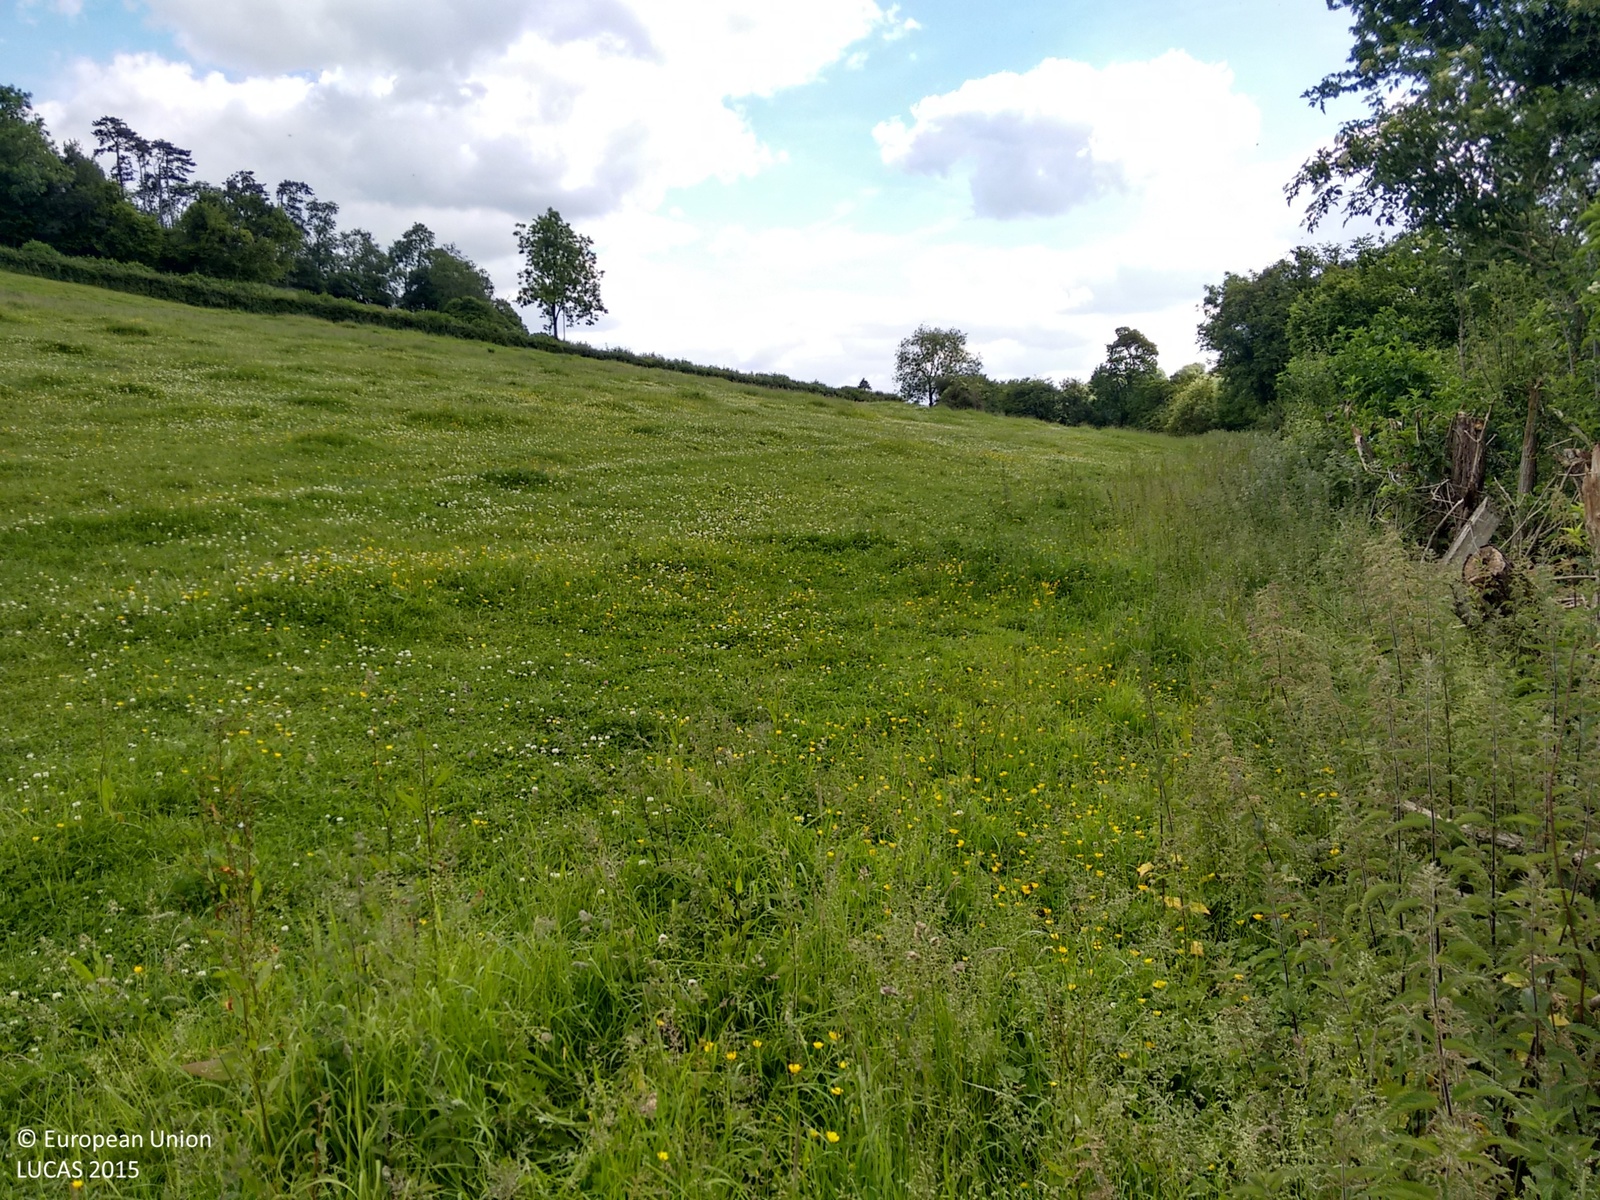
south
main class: Woodland
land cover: Broadleaved woodland
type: mesophytic deciduous forest
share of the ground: > 75 %
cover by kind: broadleaved forest trees 100 %
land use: Agriculture (excluding fallow land and kitchen gardens)
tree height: > 5 m
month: June
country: GB
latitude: 51.3485
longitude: -2.3397
